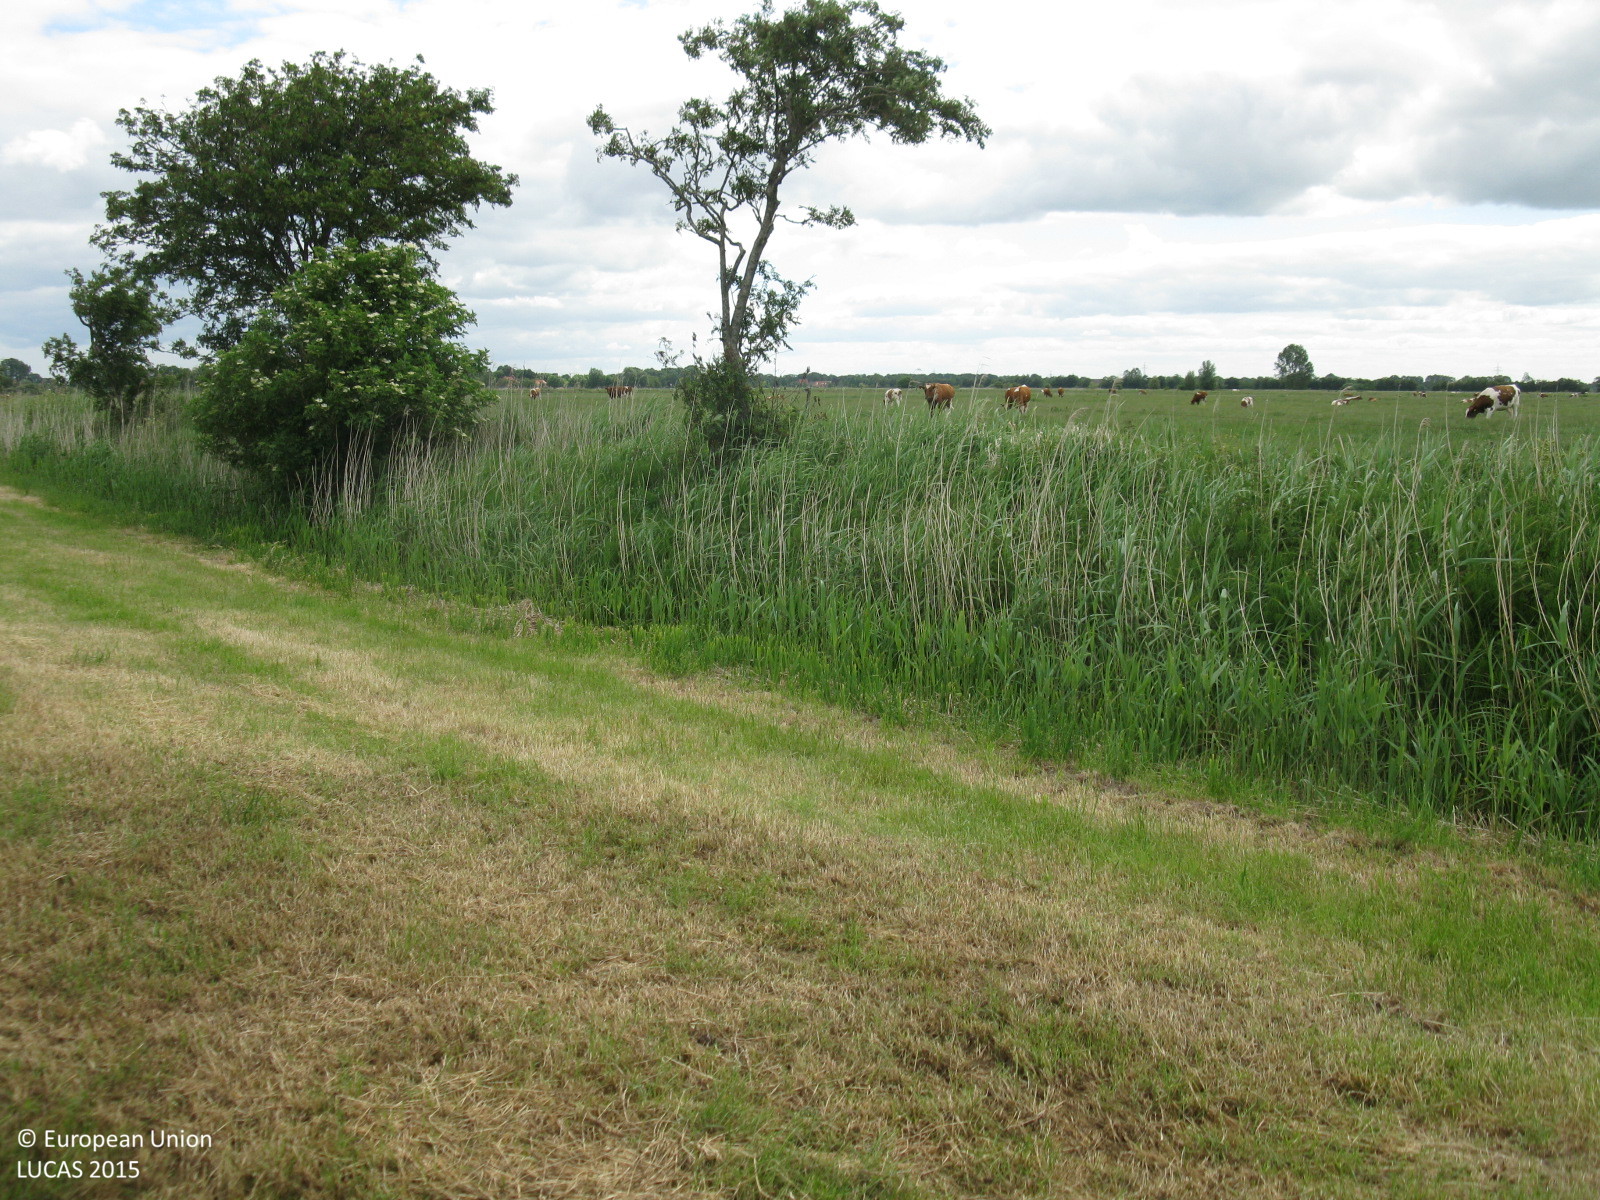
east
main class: Grassland
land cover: Grassland without tree/shrub cover
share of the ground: > 75 %
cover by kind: herbaceous plants 100 %
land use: Agriculture (excluding fallow land and kitchen gardens)
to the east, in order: Grassland without tree/shrub cover; Ditches and canals; Abandoned hedges; Tracks; Grass margins; Fences; Grass margins; Inland fresh running water; Grass margins; Fences; Grassland without tree/shrub cover
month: June
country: DE
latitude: 53.3022
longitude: 7.4046
